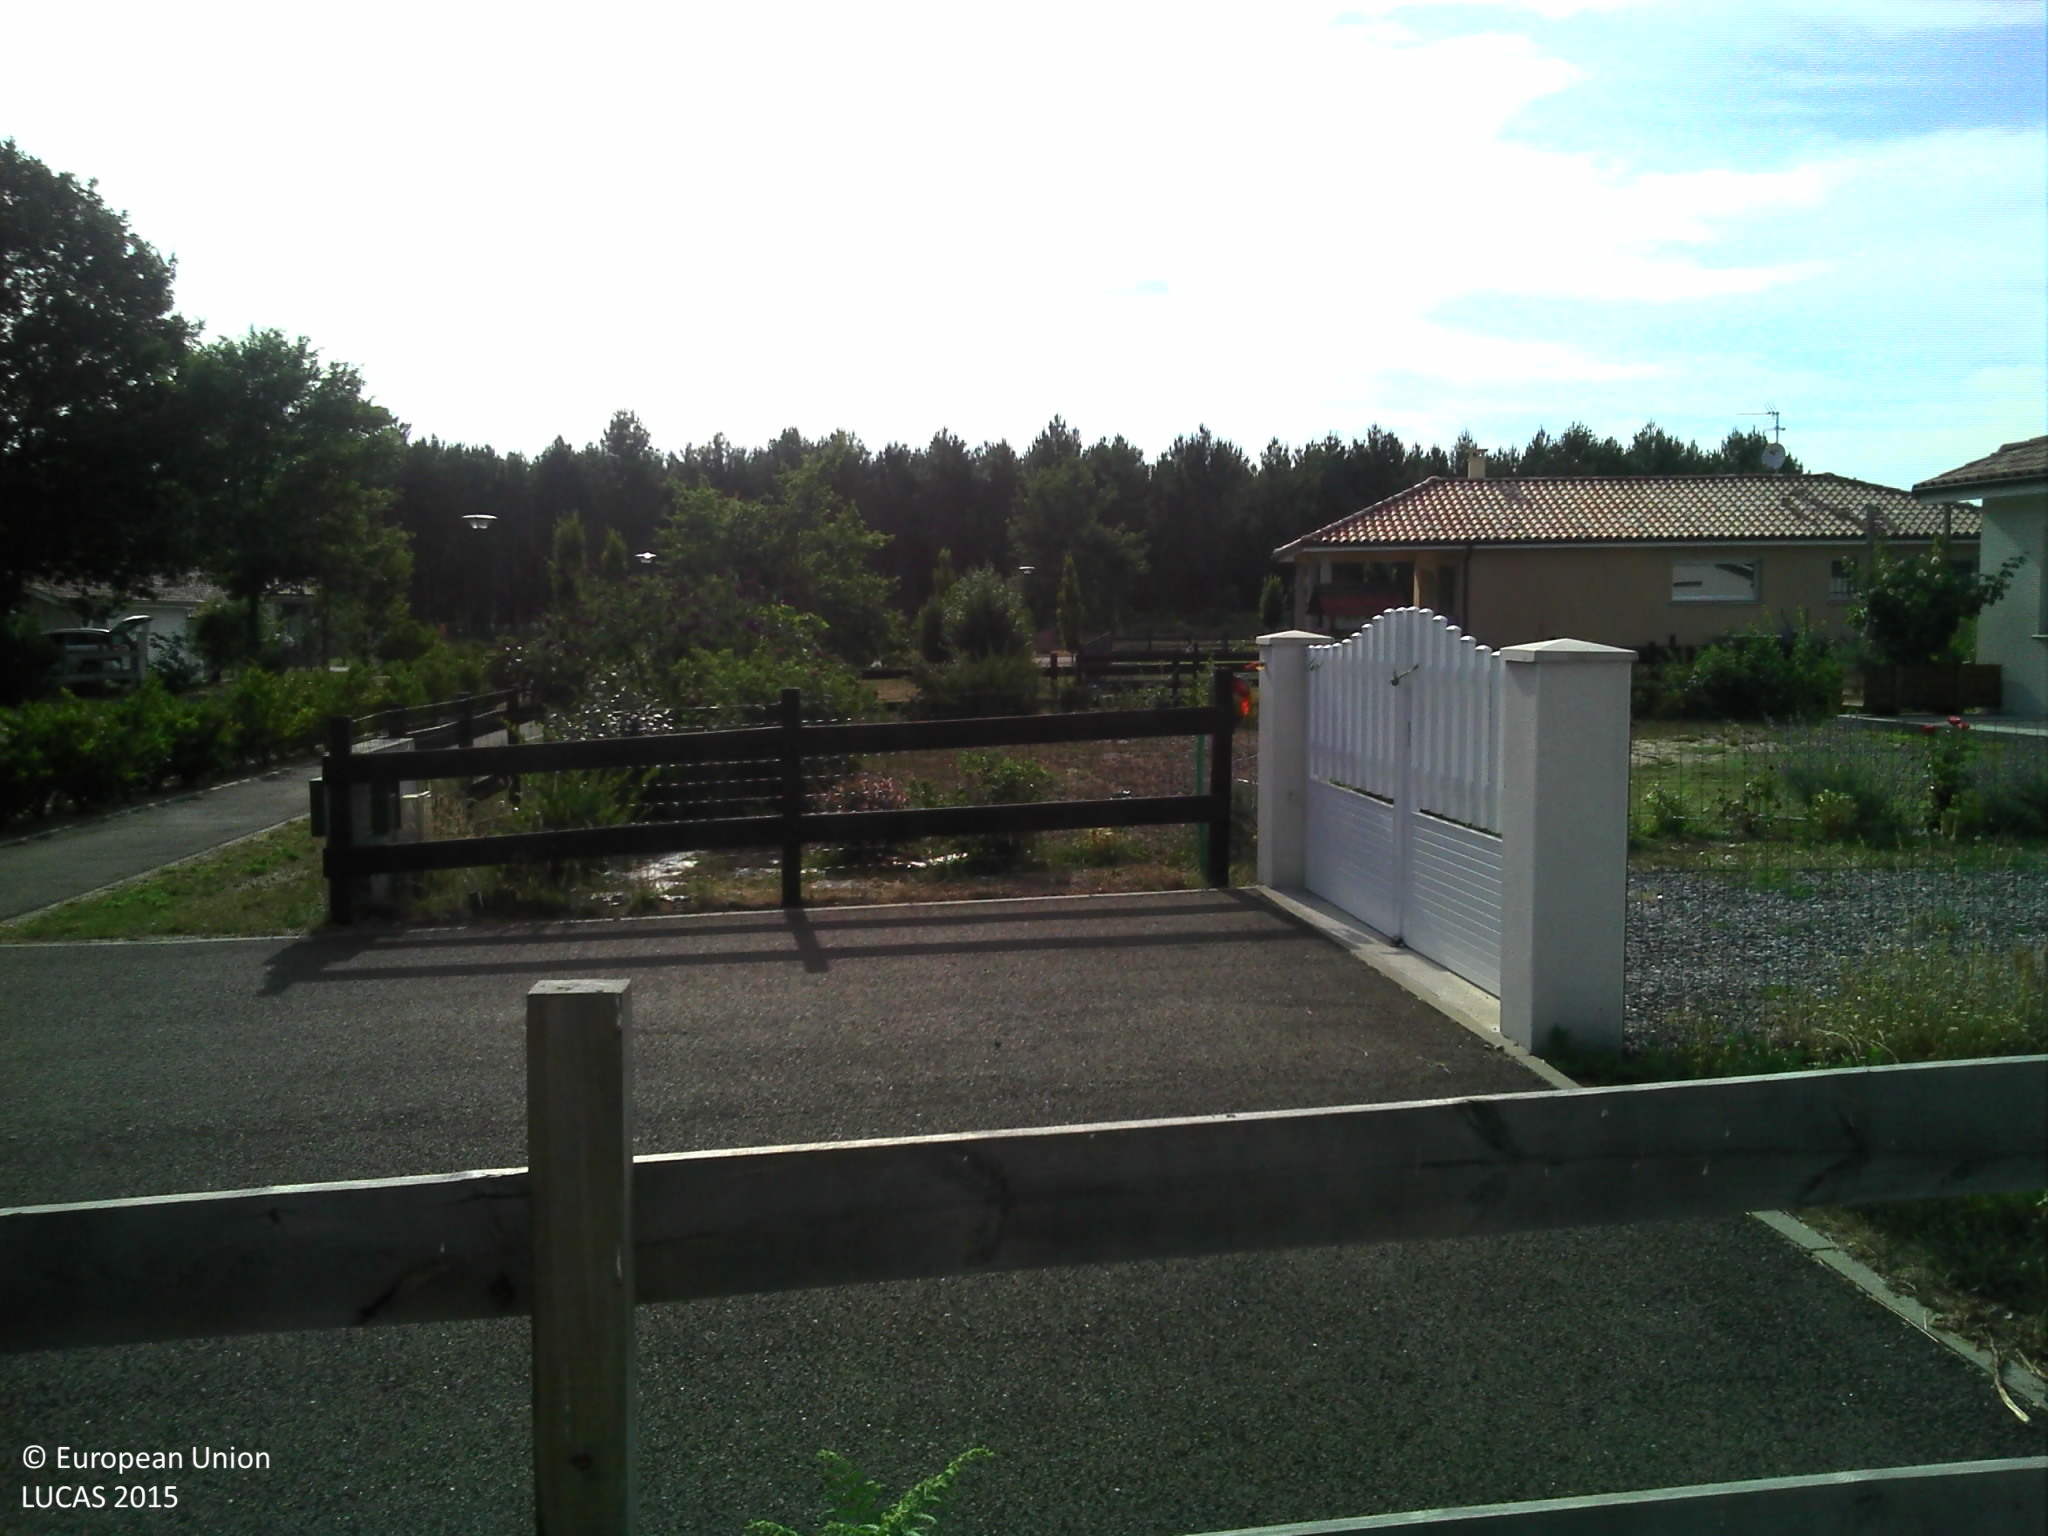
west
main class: Grassland
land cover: Grassland without tree/shrub cover
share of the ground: > 75 %
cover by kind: herbaceous plants 100 %
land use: Residential
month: July
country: FR
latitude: 43.9117
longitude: -1.3141
